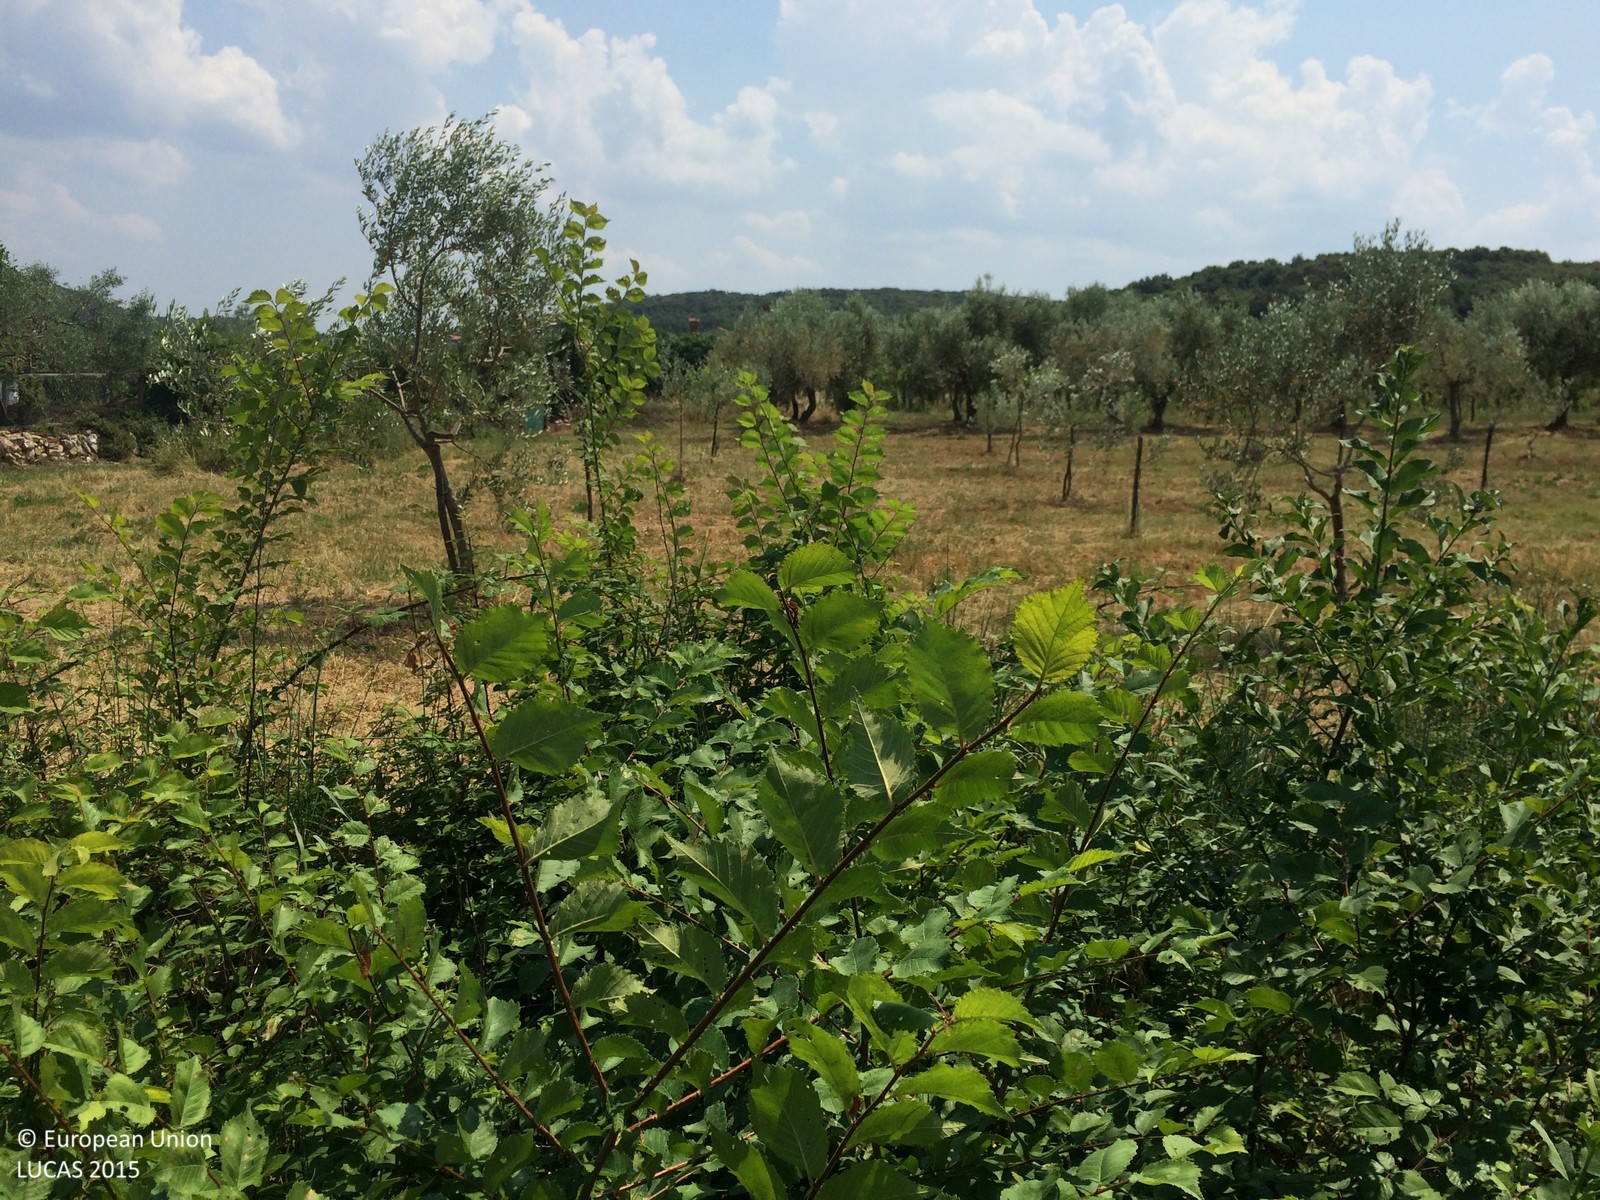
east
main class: Shrubland
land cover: Shrubland without tree cover
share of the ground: < 10 %
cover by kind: herbaceous plants 90 %, shrubs 10 %
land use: Semi-natural and natural areas not in use
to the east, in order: Shrubland without tree cover; Spontaneously vegetated surfaces; Olive groves; Tracks; Single bushes/trees; Grassland without tree/shrub cover; Vineyards; Grass margins; Shrubland with sparse tree cover; Ditches and canals; Shrubland without tree cover; Grassland without tree/shrub cover; Nuts trees; Grassland without tree/shrub cover; Shrubland without tree cover; Single bushes/trees; Grassland without tree/shrub cover; Apple fruit; Permanent industrial crops; Grassland without tree/shrub cover; Spontaneously vegetated surfaces
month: June
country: HR
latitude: 45.1168
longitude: 13.6429
